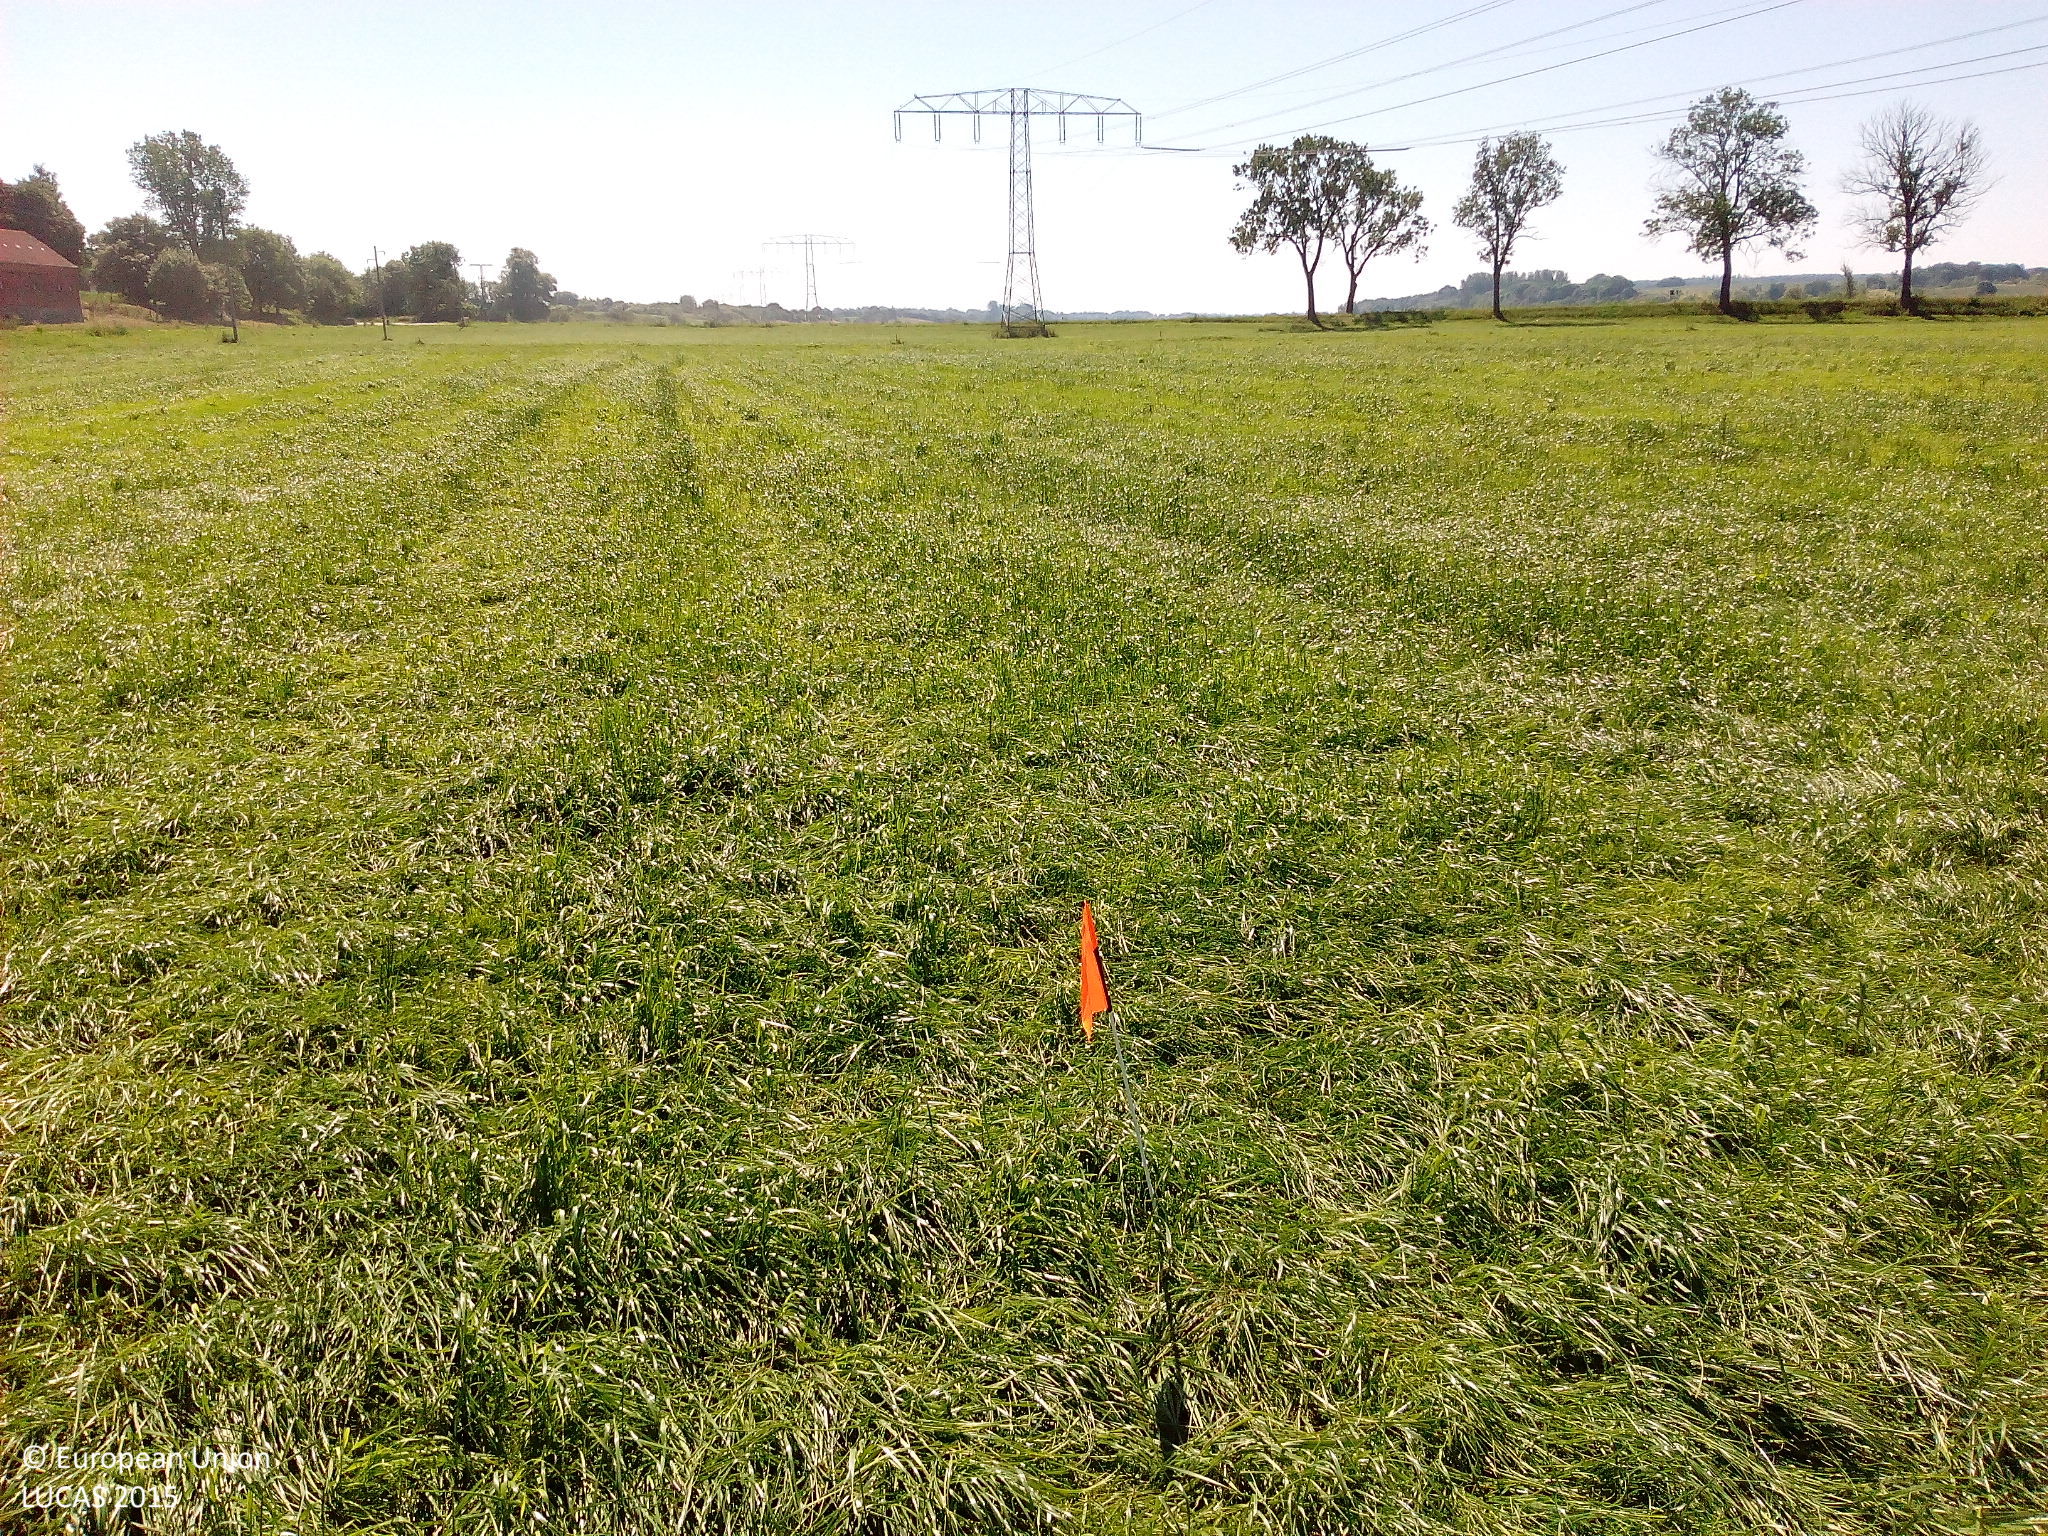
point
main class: Grassland
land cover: Grassland without tree/shrub cover
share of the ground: > 75 %
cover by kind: herbaceous plants 100 %
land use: Agriculture (excluding fallow land and kitchen gardens)
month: July
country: DE
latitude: 53.8444
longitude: 13.2368
